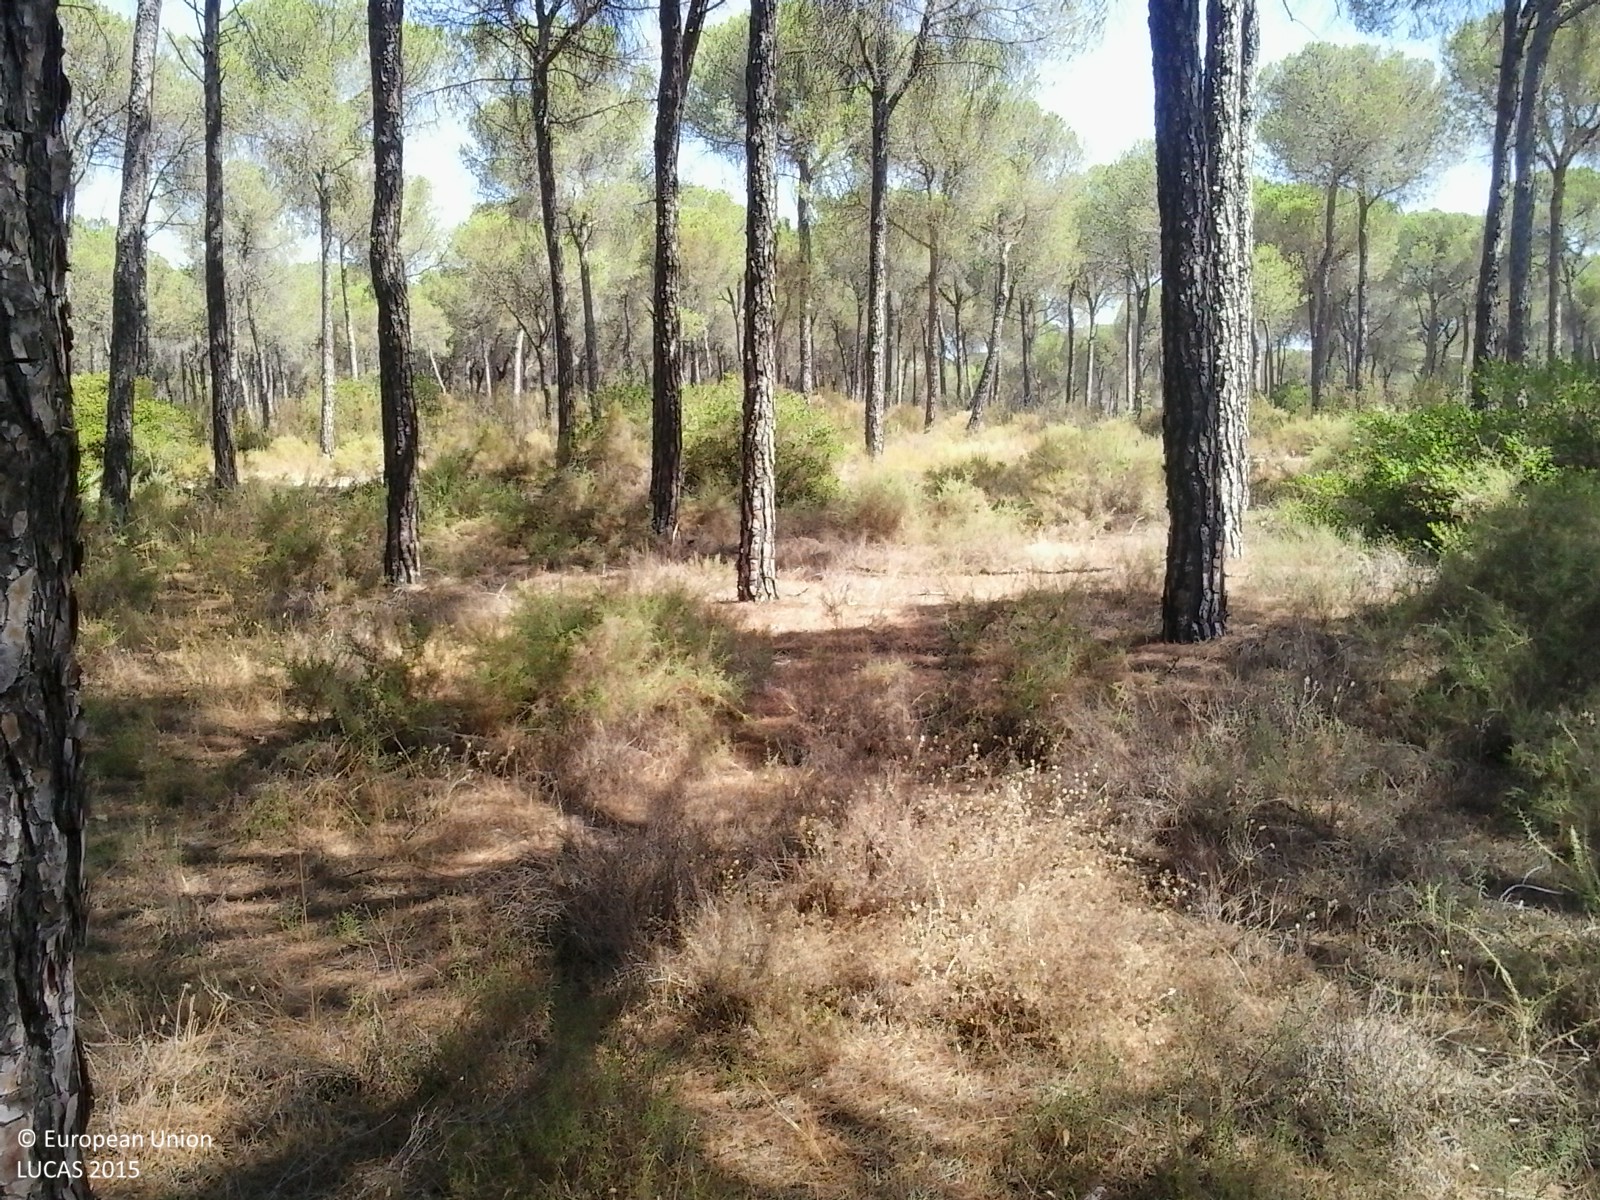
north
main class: Woodland
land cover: Pine dominated coniferous woodland
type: coniferous forest of the mediterranean region
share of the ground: > 75 %
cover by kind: coniferous forest trees 75 %, herbaceous plants 15 %, shrubs 10 %
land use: Forestry
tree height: > 5 m
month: July
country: ES
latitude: 37.2388
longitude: -6.3836
